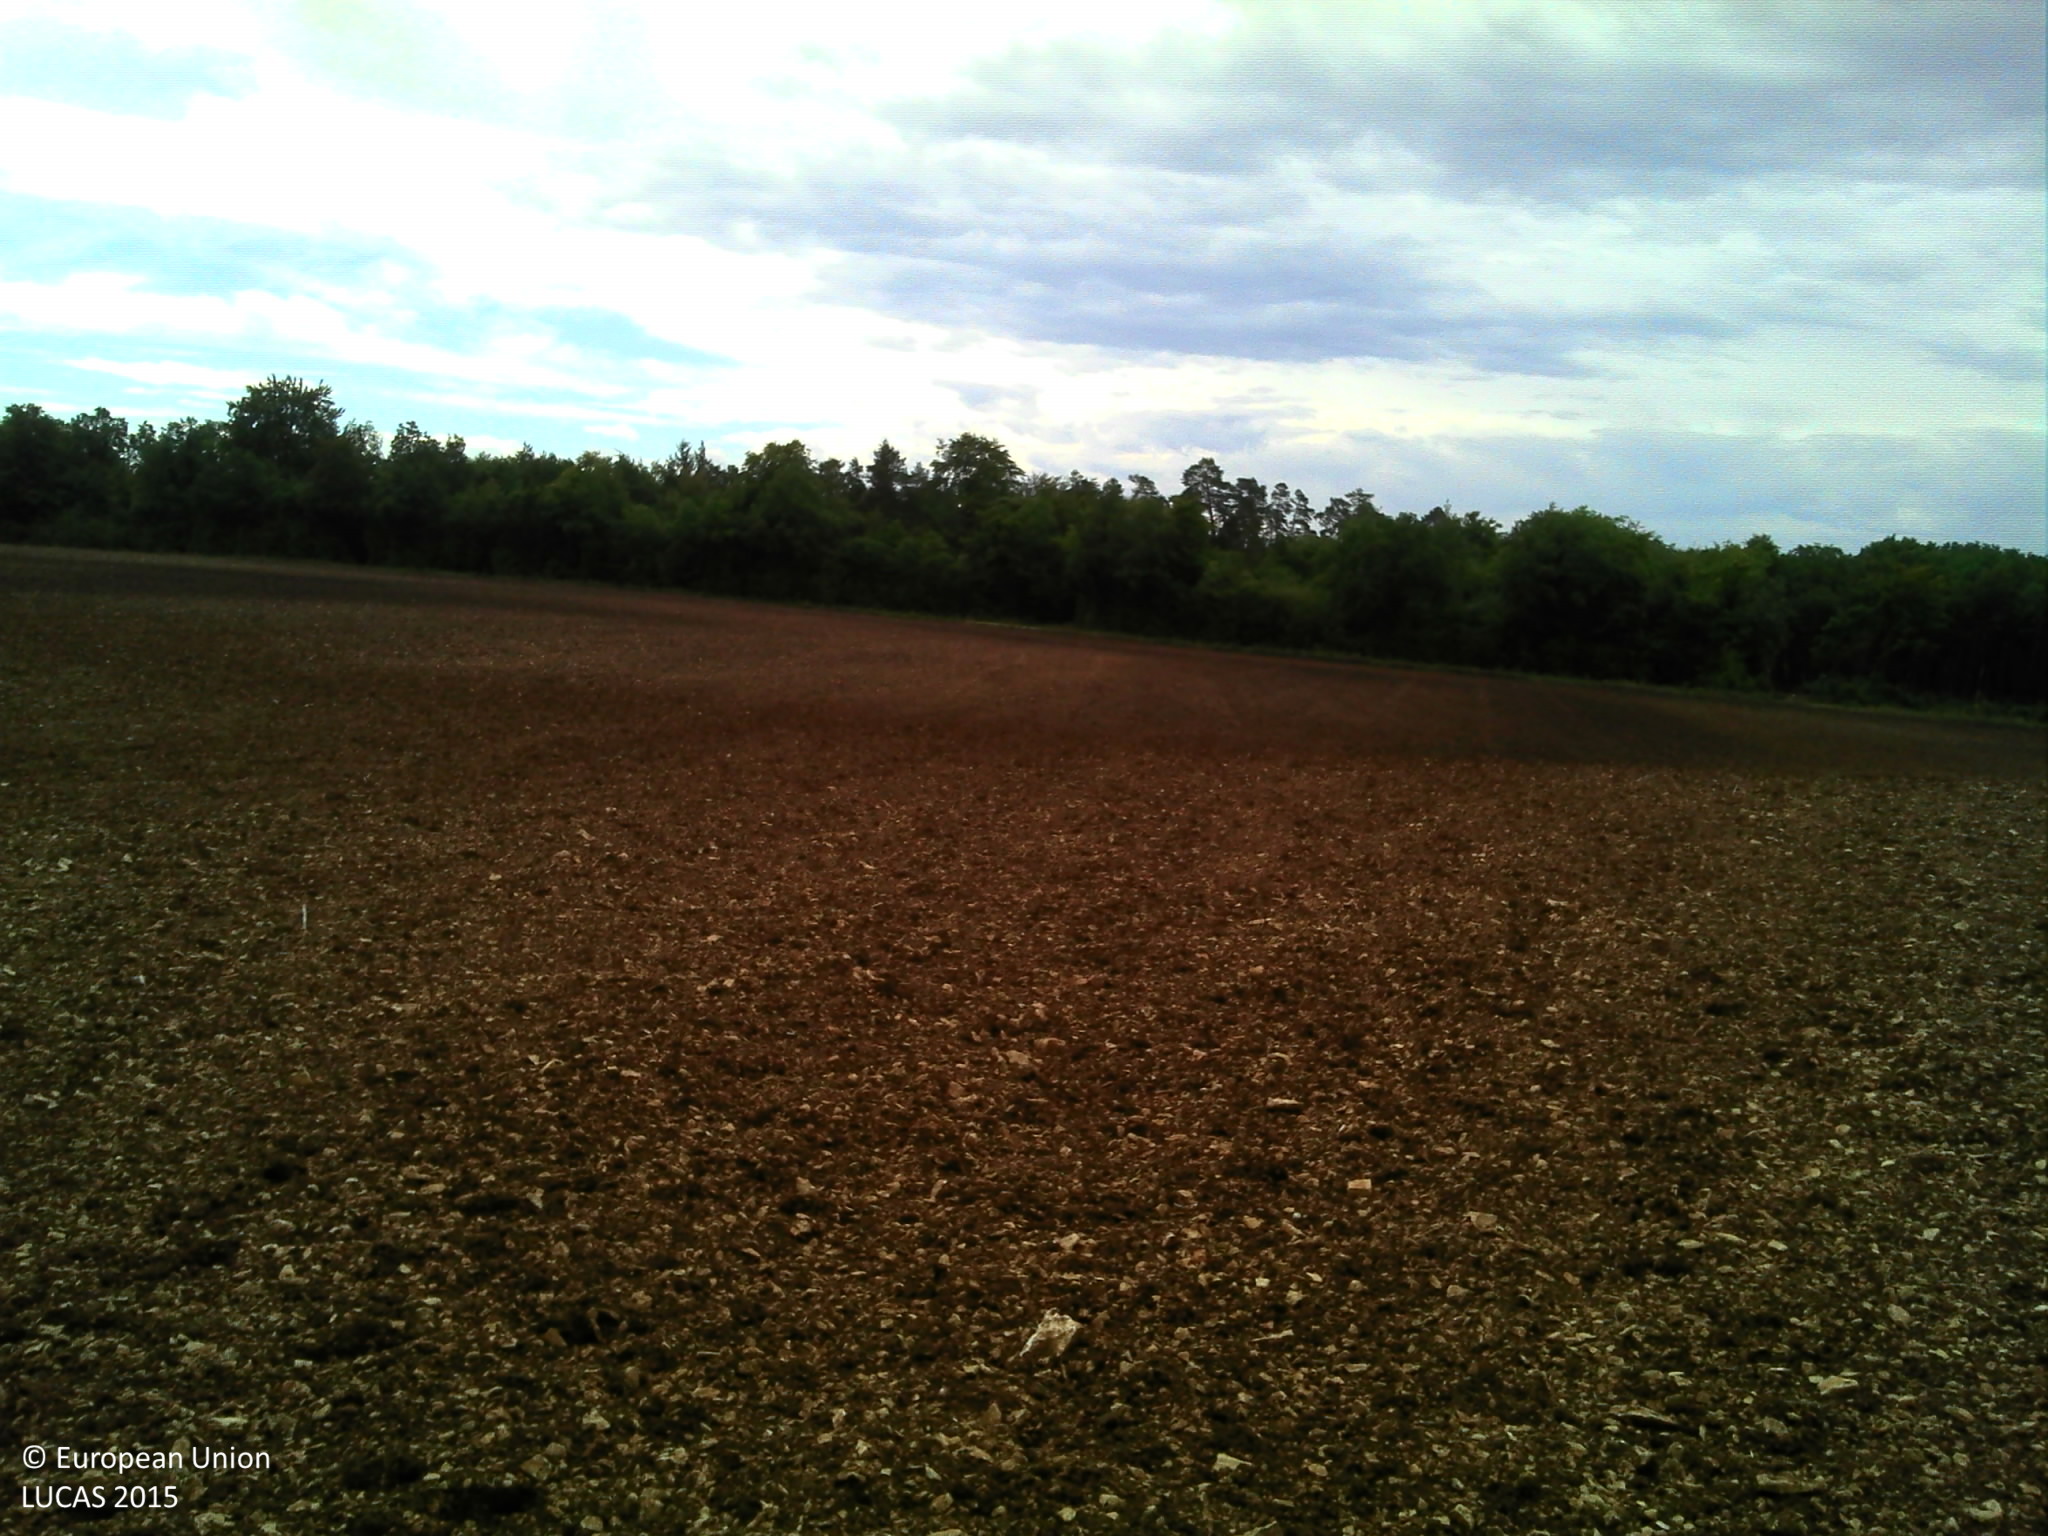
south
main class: Cropland
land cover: Rape and turnip rape
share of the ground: < 10 %
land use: Agriculture (excluding fallow land and kitchen gardens)
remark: Tilled/Sowed
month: September
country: FR
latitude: 47.6618
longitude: 4.3123
